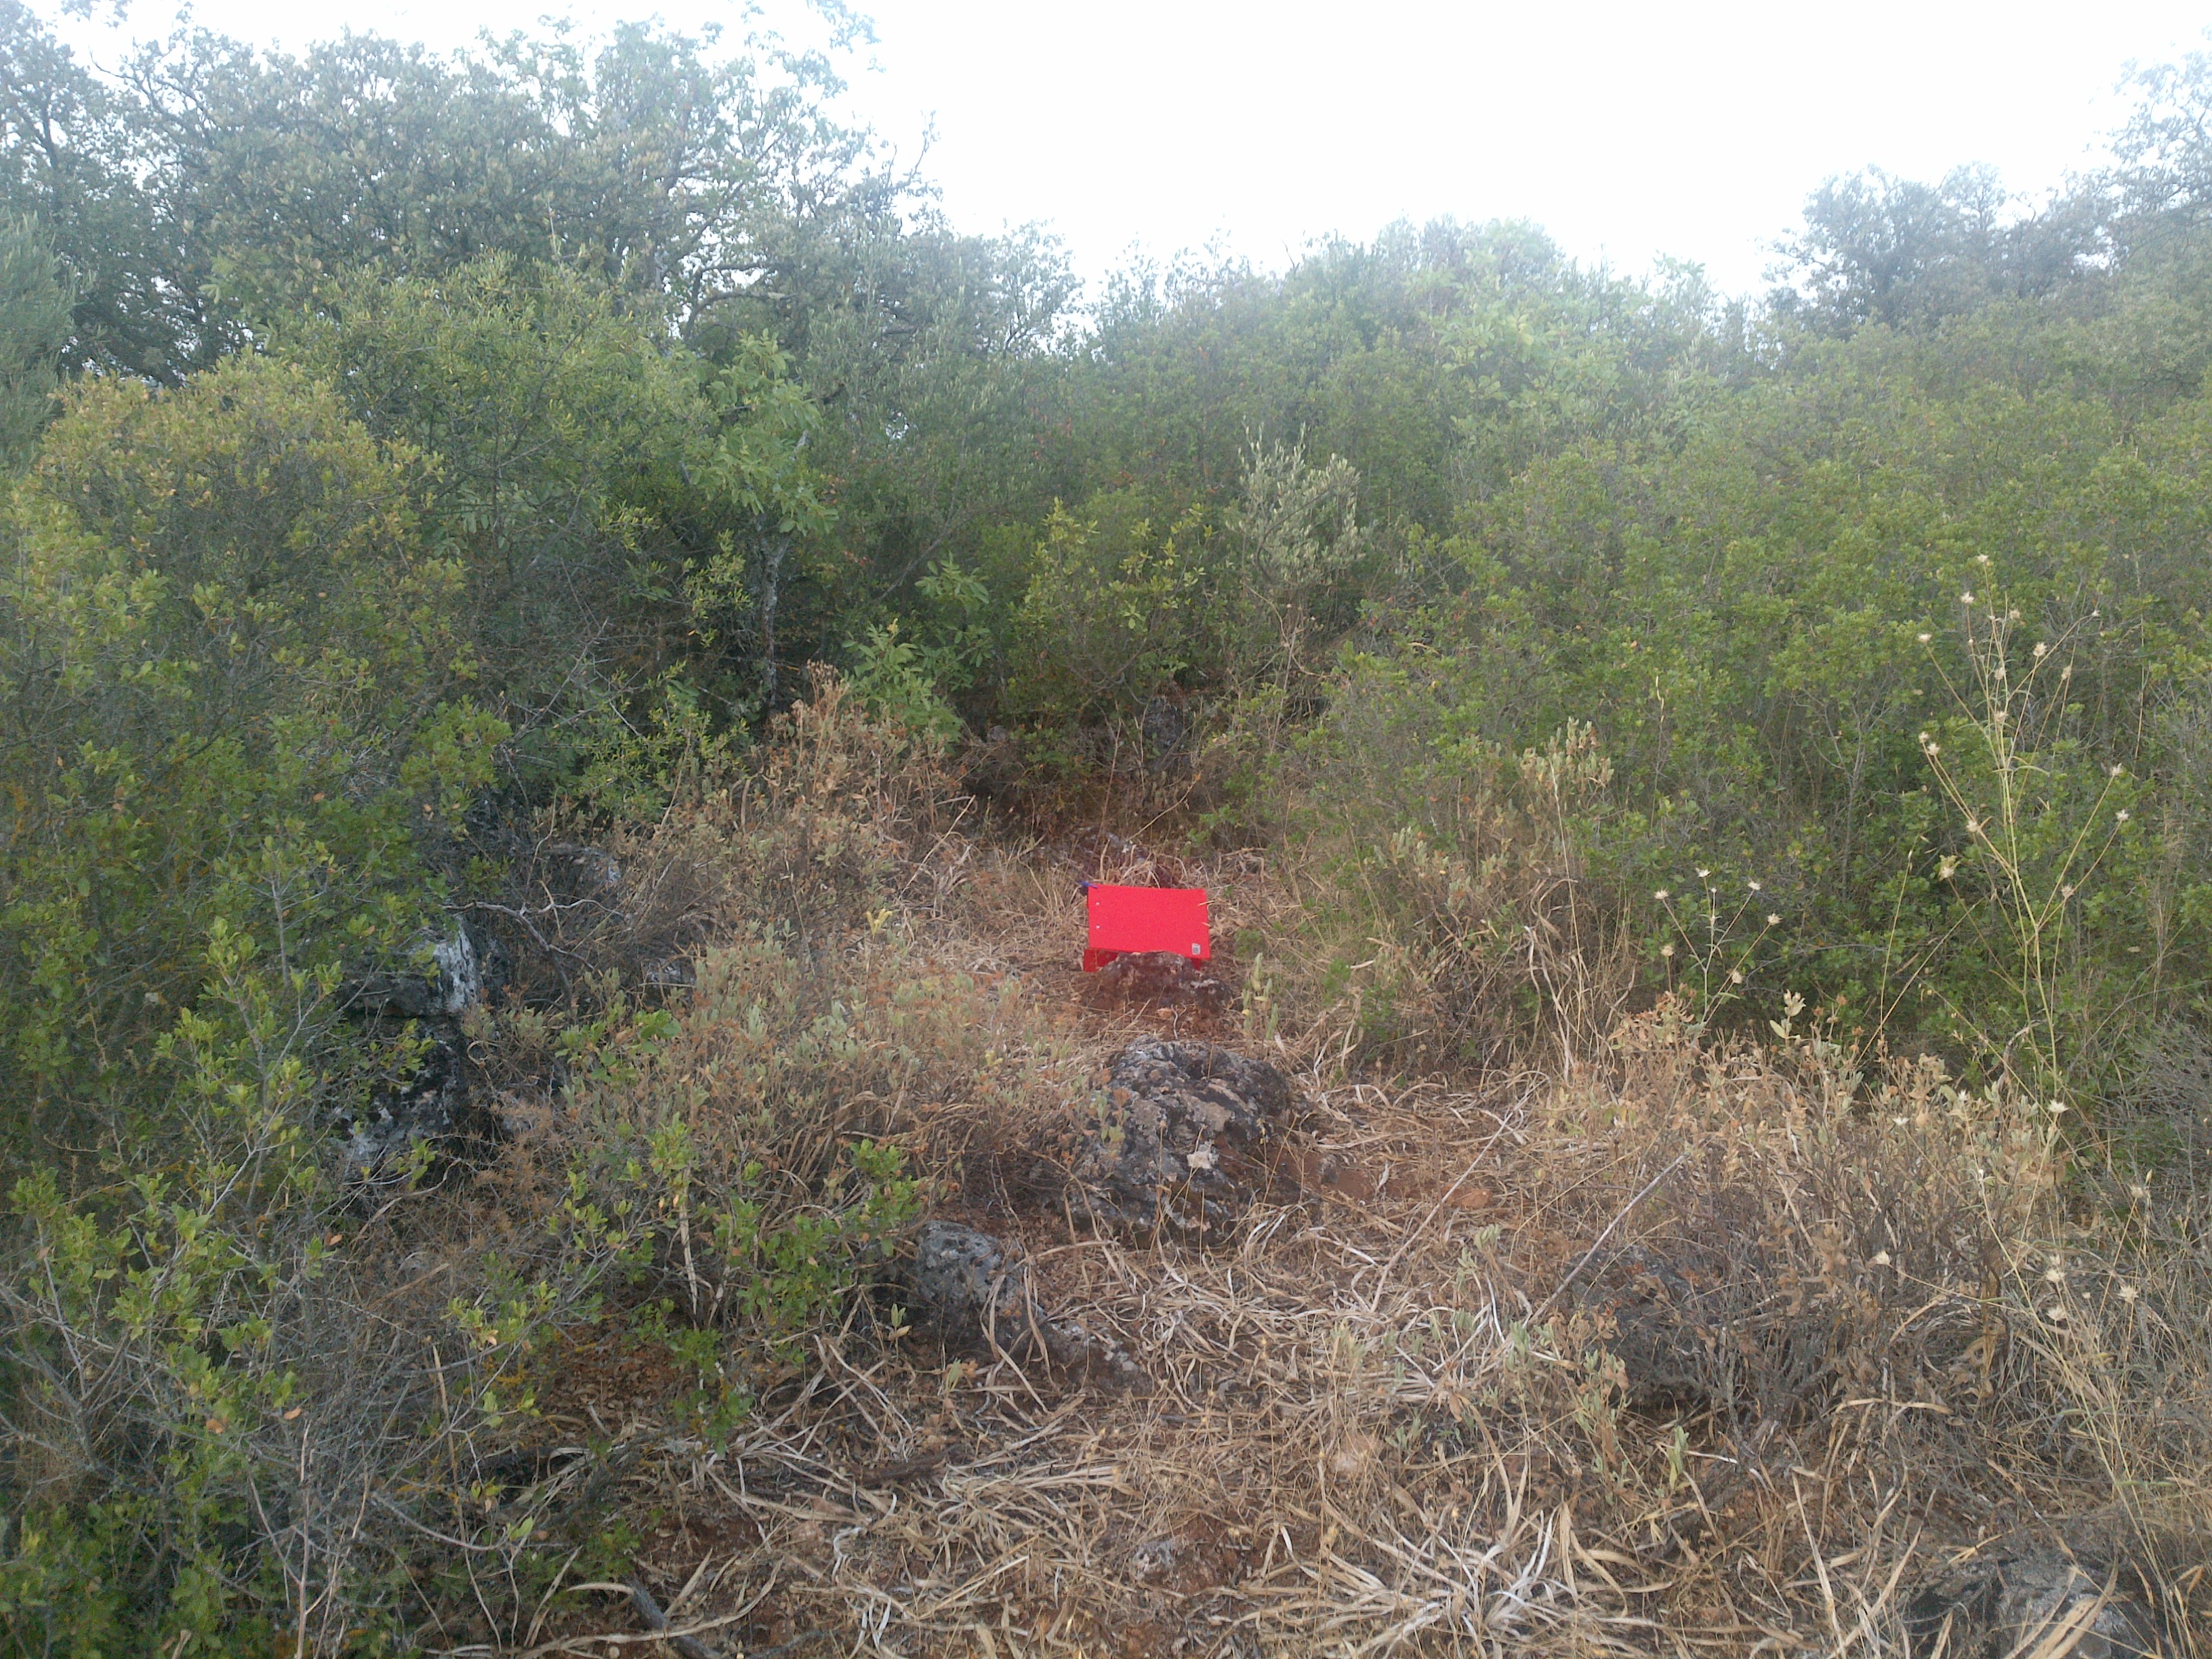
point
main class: Shrubland
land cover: Shrubland with sparse tree cover
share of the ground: 50 - 75 %
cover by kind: shrubs 50 %, unconsolidated bare surface 30 %, herbaceous plants 15 %, broadleaved forest trees 5 %
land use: Semi-natural and natural areas not in use
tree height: < 5 m
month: July
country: ES
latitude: 37.4875
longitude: -4.4230
